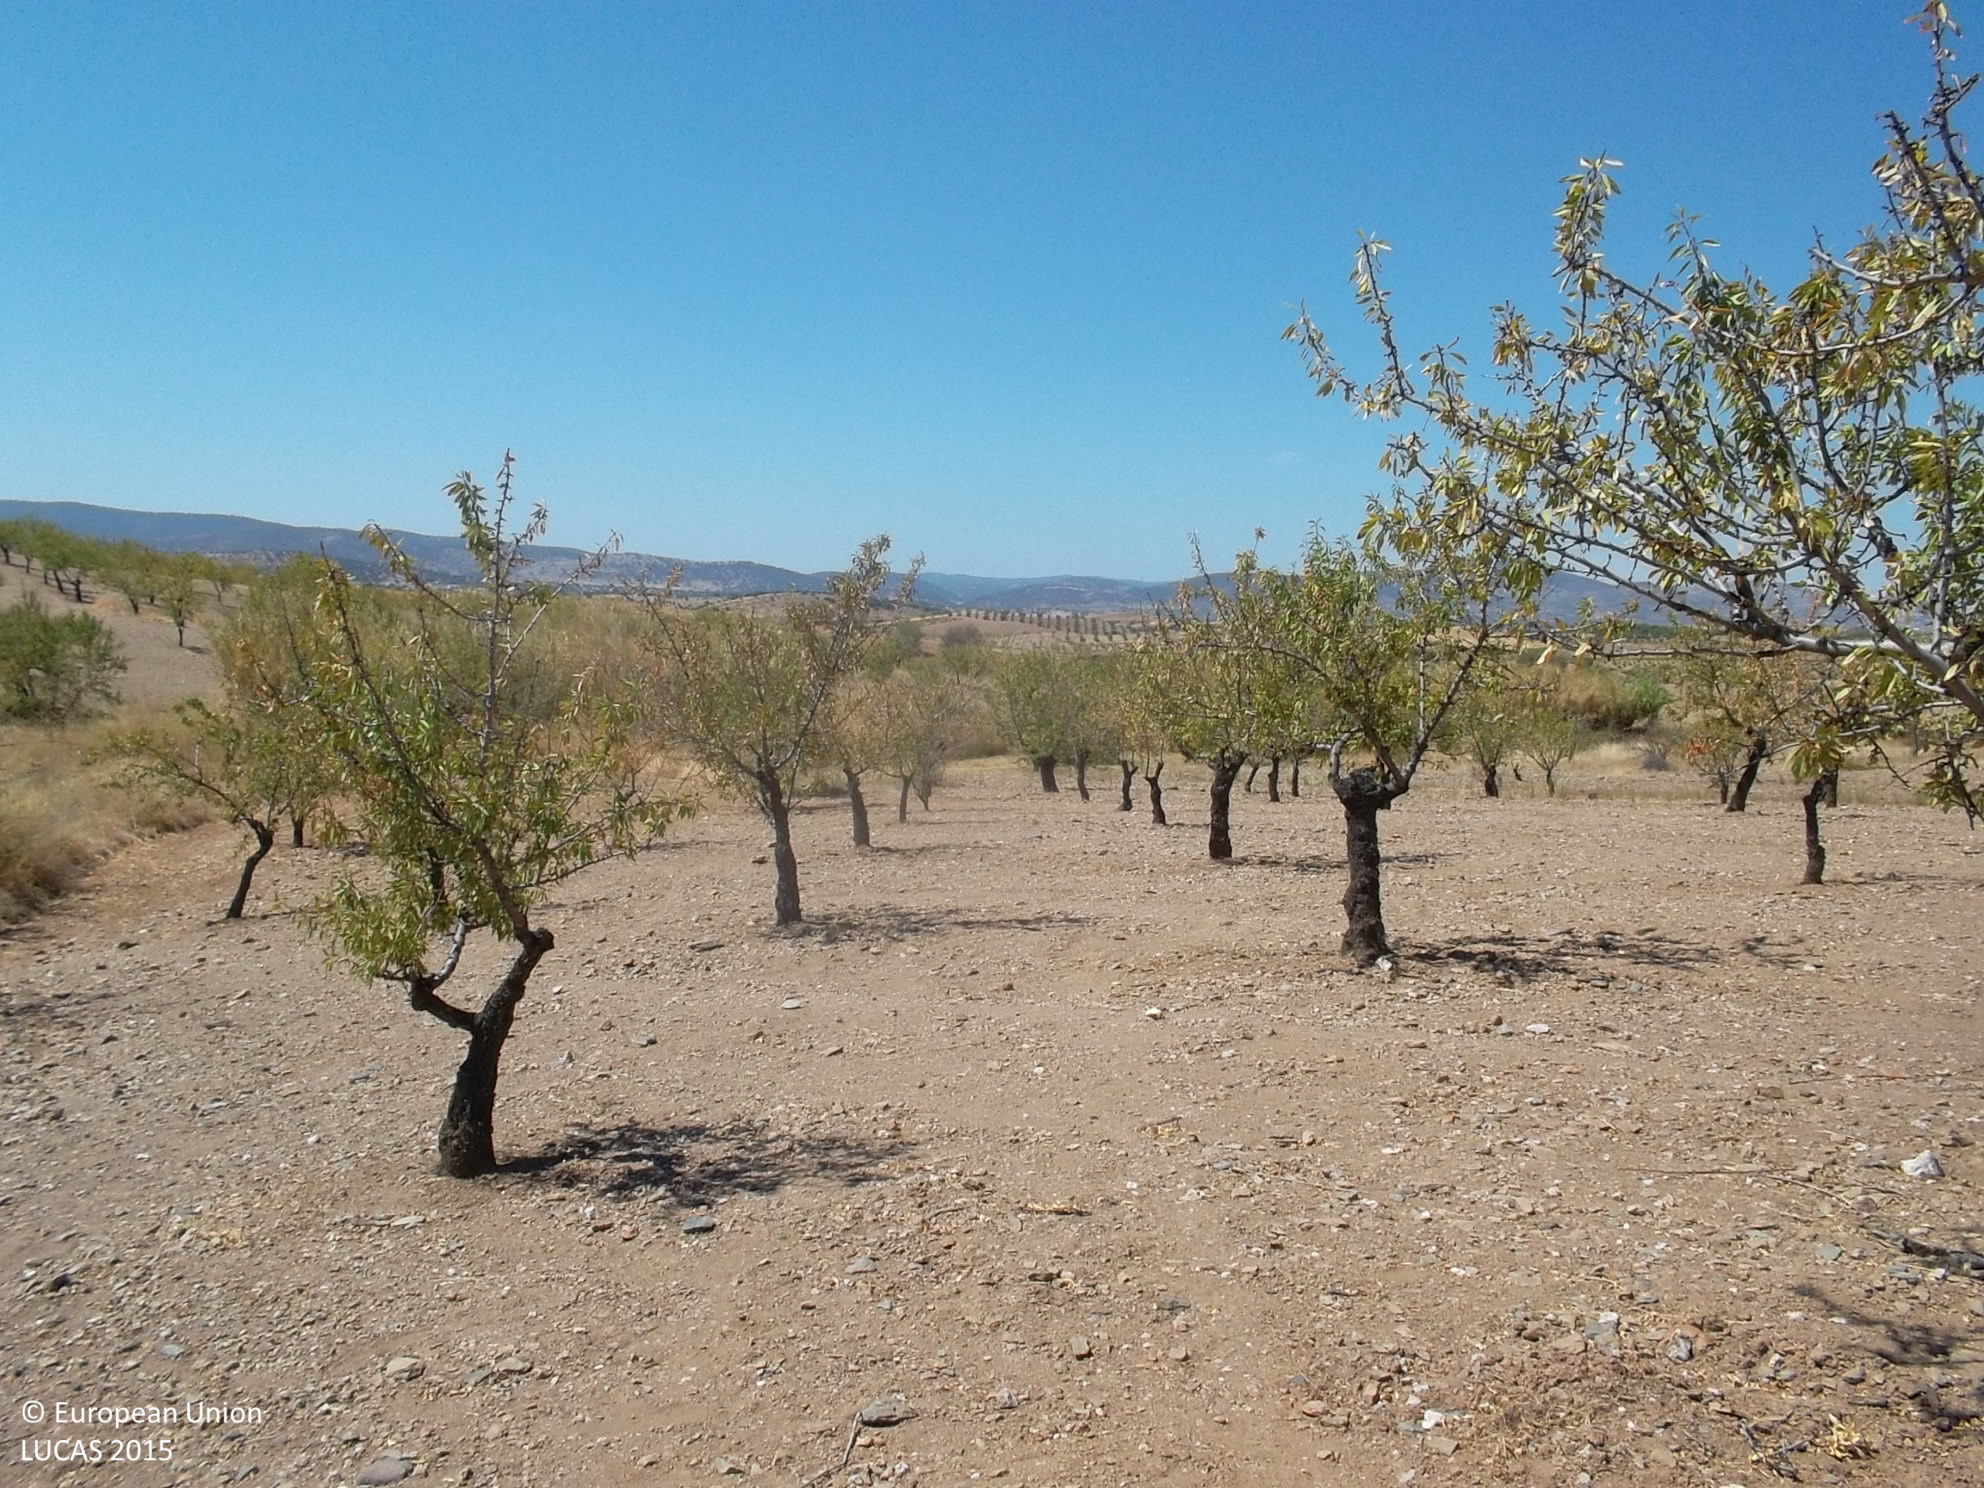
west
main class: Cropland
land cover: Nuts trees
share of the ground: 50 - 75 %
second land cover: Other bare soil
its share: > 75 %
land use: Agriculture (excluding fallow land and kitchen gardens)
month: August
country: ES
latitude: 38.5016
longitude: -6.4380
